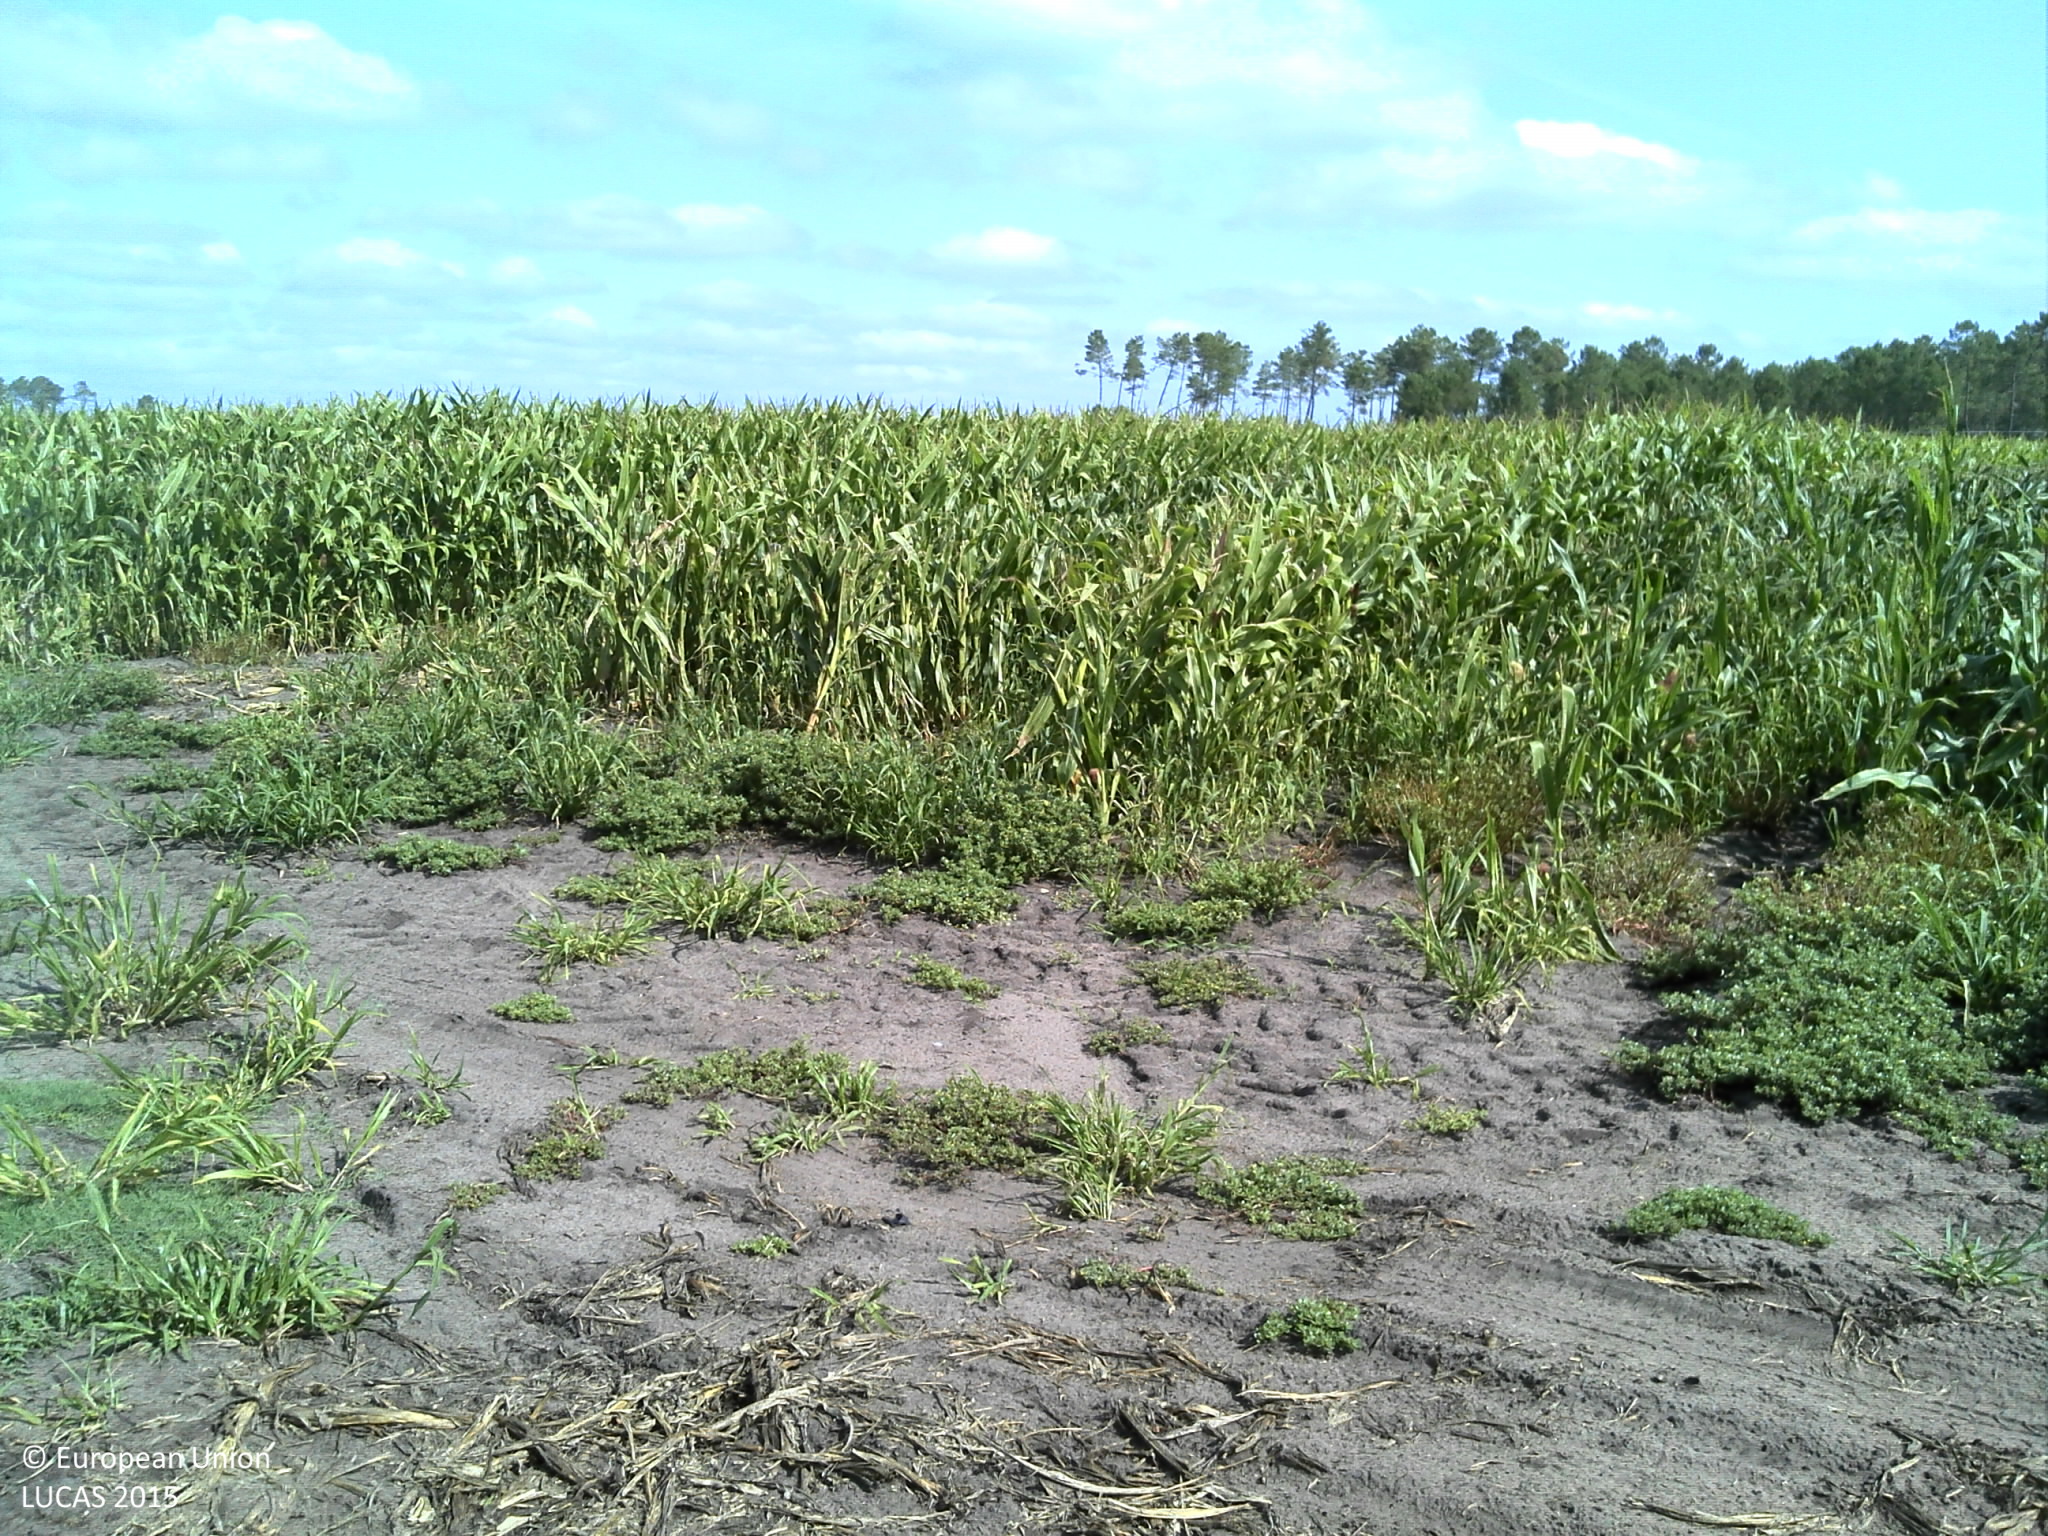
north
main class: Cropland
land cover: Maize
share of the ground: > 75 %
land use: Agriculture (excluding fallow land and kitchen gardens)
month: August
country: FR
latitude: 44.3752
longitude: -0.5451
